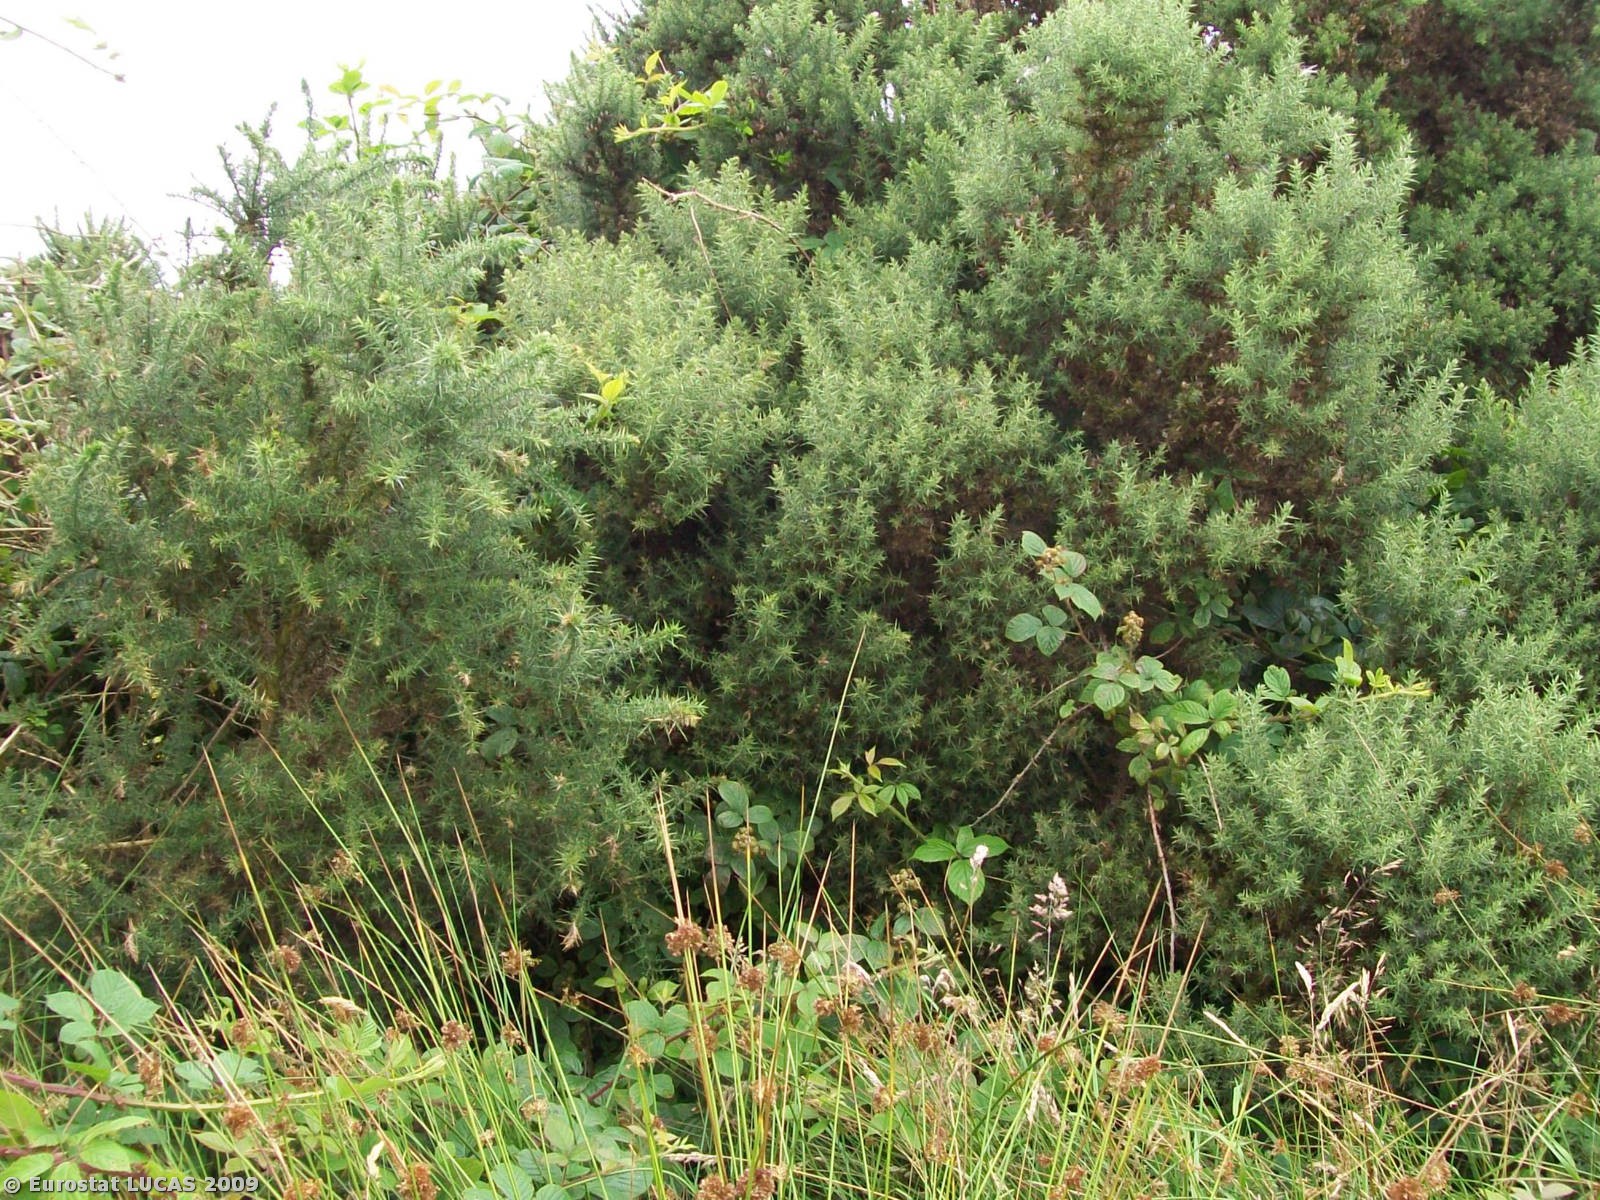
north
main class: Grassland
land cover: Grassland without tree/shrub cover
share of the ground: > 75 %
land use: Agriculture (excluding fallow land and kitchen gardens)
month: August
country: GB
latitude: 54.1271
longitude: -6.5461
